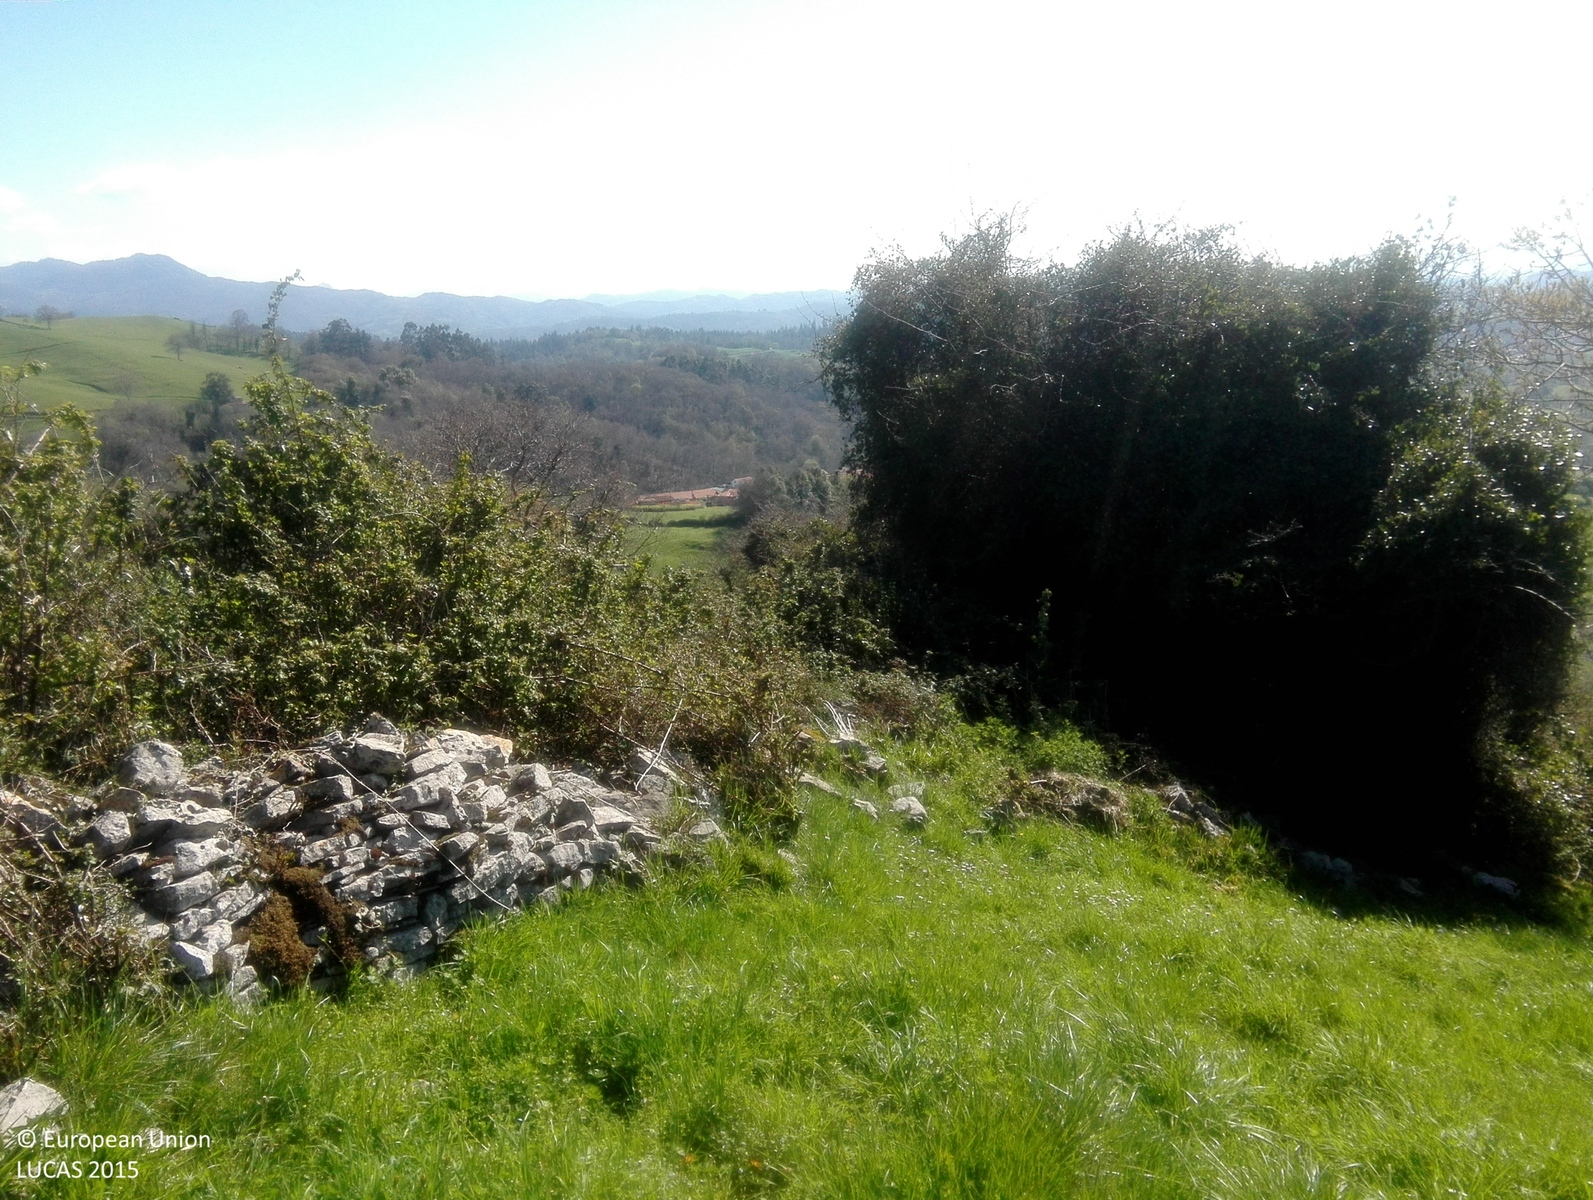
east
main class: Grassland
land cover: Grassland without tree/shrub cover
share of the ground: > 75 %
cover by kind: herbaceous plants 100 %
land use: Agriculture (excluding fallow land and kitchen gardens)
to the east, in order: Grassland without tree/shrub cover; Dry stone walls; Grassland without tree/shrub cover; Abandoned hedges; Grass margins; Paved roads, cycling and walking lanes; Grass margins; Fences; Grassland without tree/shrub cover; Fences; Grassland without tree/shrub cover; Fences; Grassland without tree/shrub cover; Single bushes/trees; Grassland without tree/shrub cover; Broadleaved woodland; Grassland without tree/shrub cover; Broadleaved woodland
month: April
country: ES
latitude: 43.4149
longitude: -5.5061
